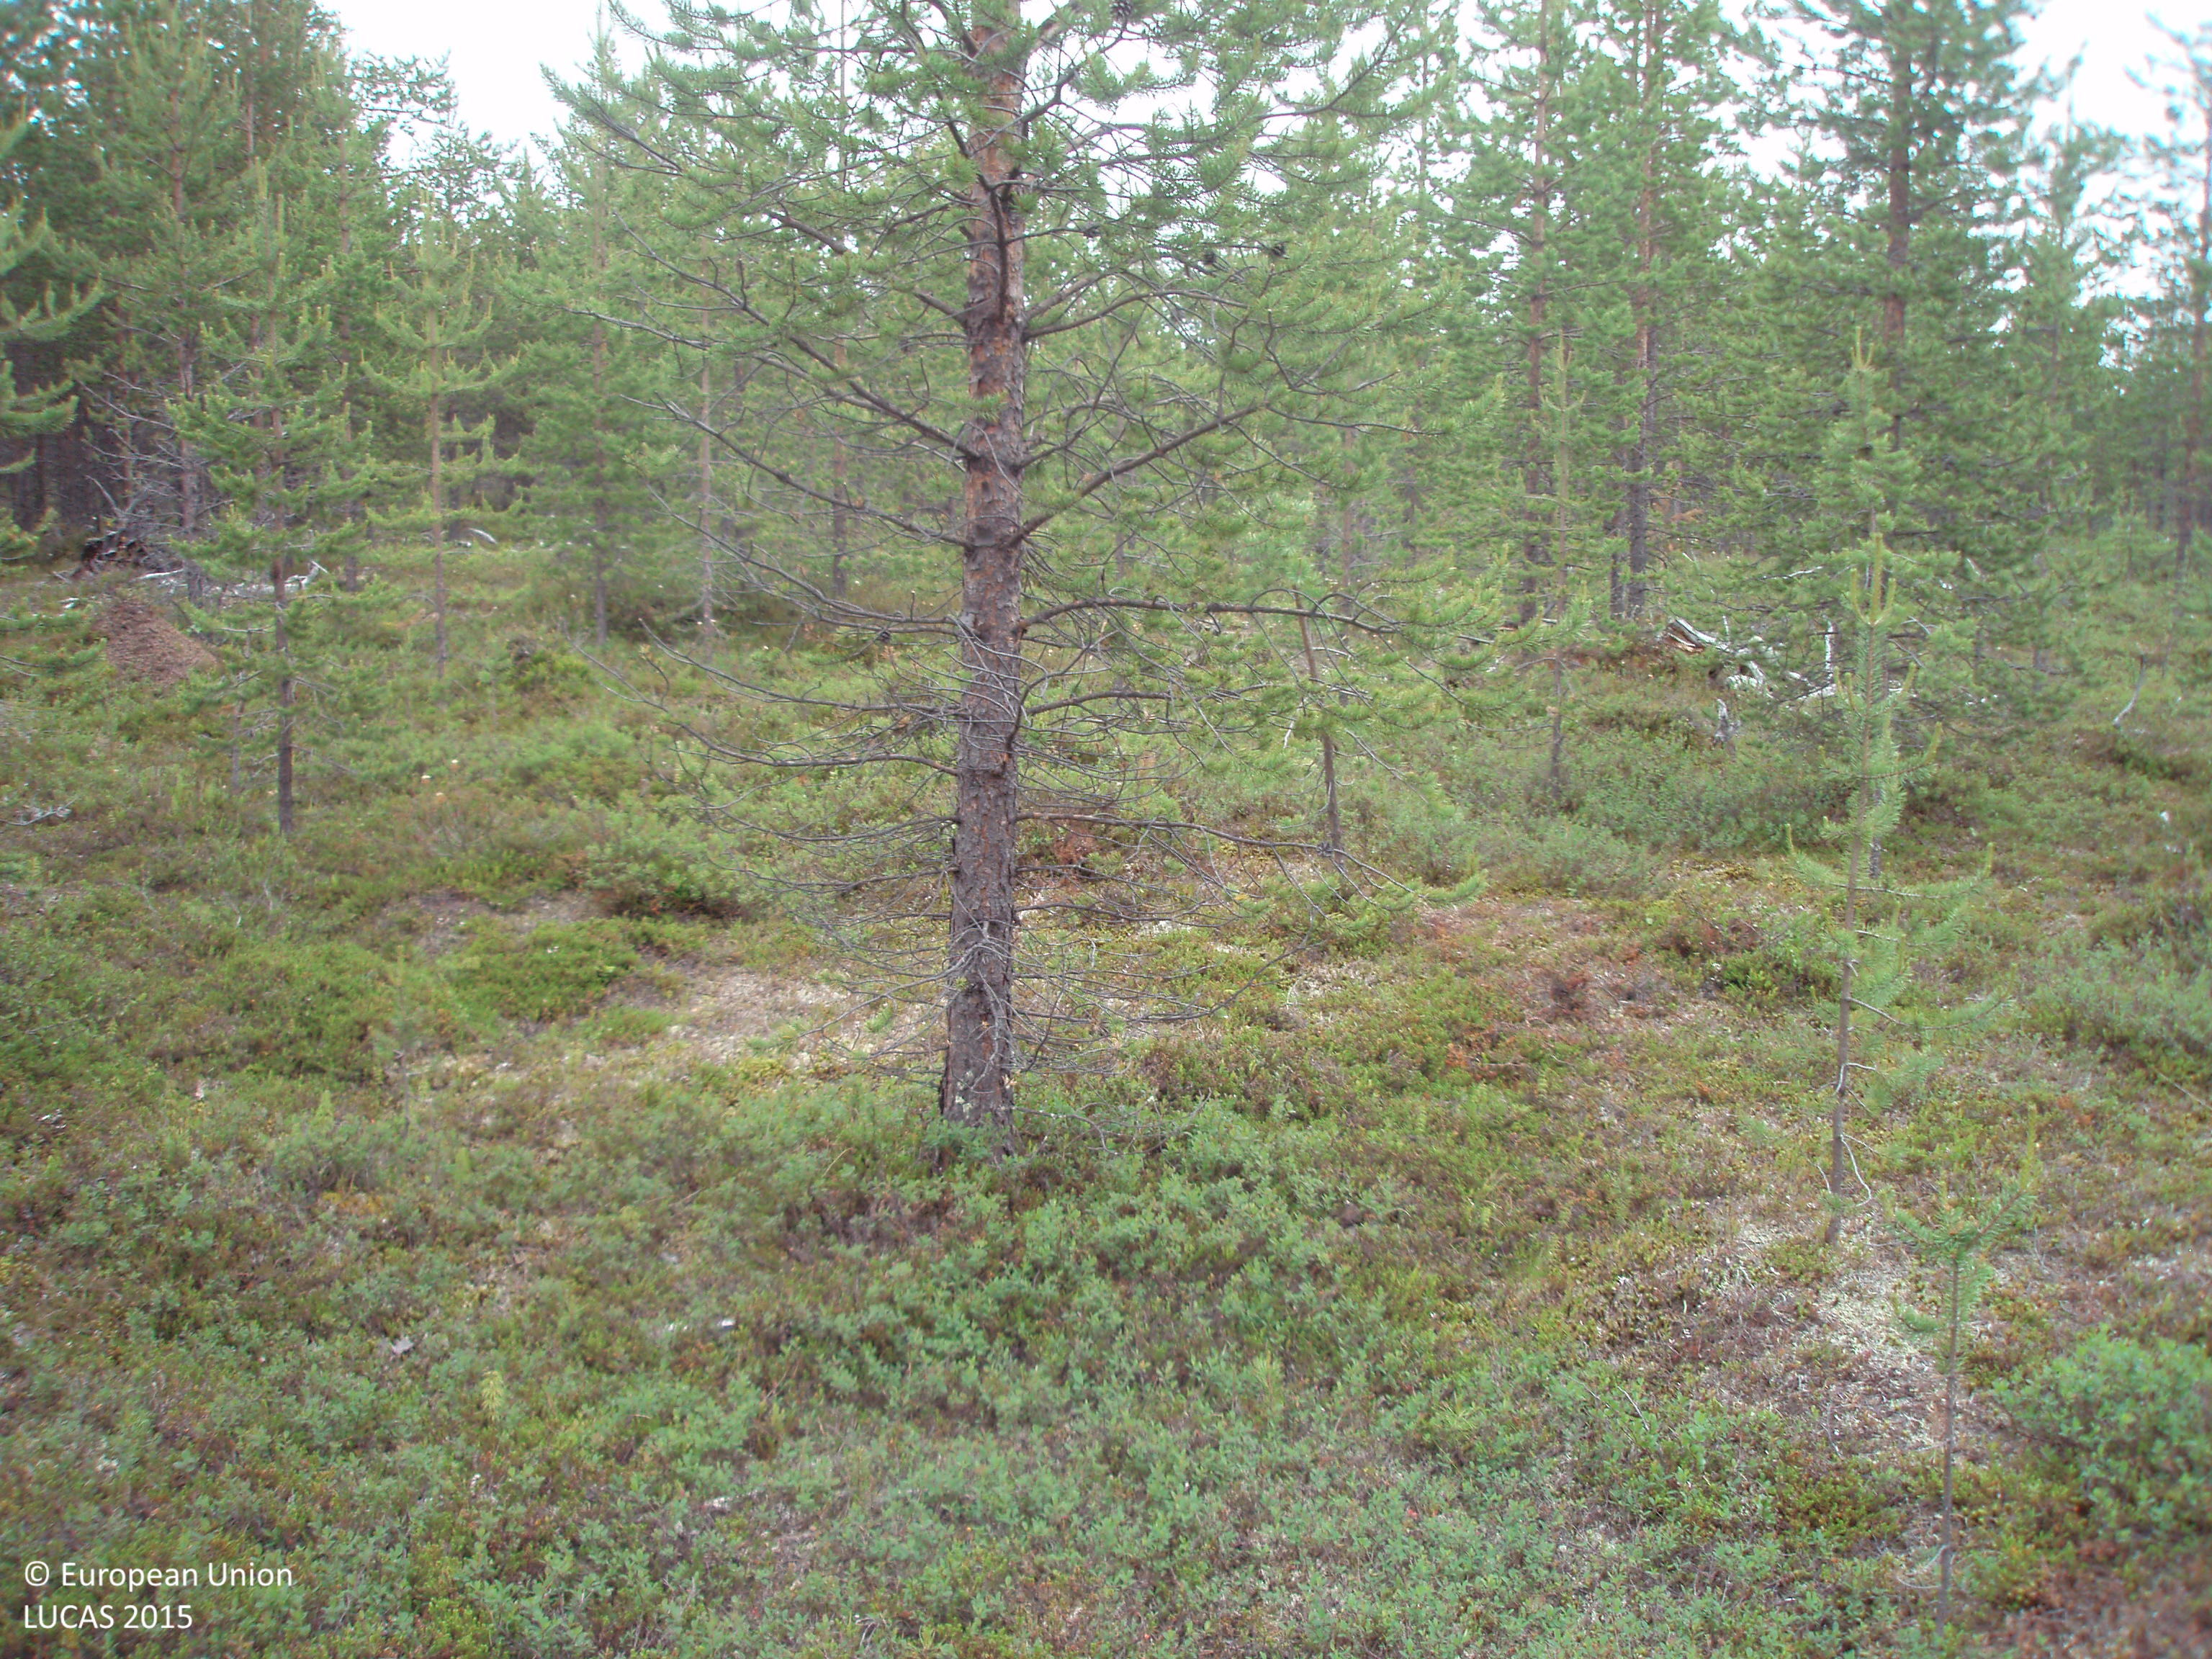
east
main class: Woodland
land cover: Pine dominated coniferous woodland
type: boreal forest
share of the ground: 25 - 50 %
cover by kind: shrubs 60 %, coniferous forest trees 35 %, lichens and mosses 5 %
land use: Forestry
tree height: < 5 m
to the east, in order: Pine dominated coniferous woodland; Tracks; Pine dominated coniferous woodland
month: July
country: FI
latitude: 67.7649
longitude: 29.0639
